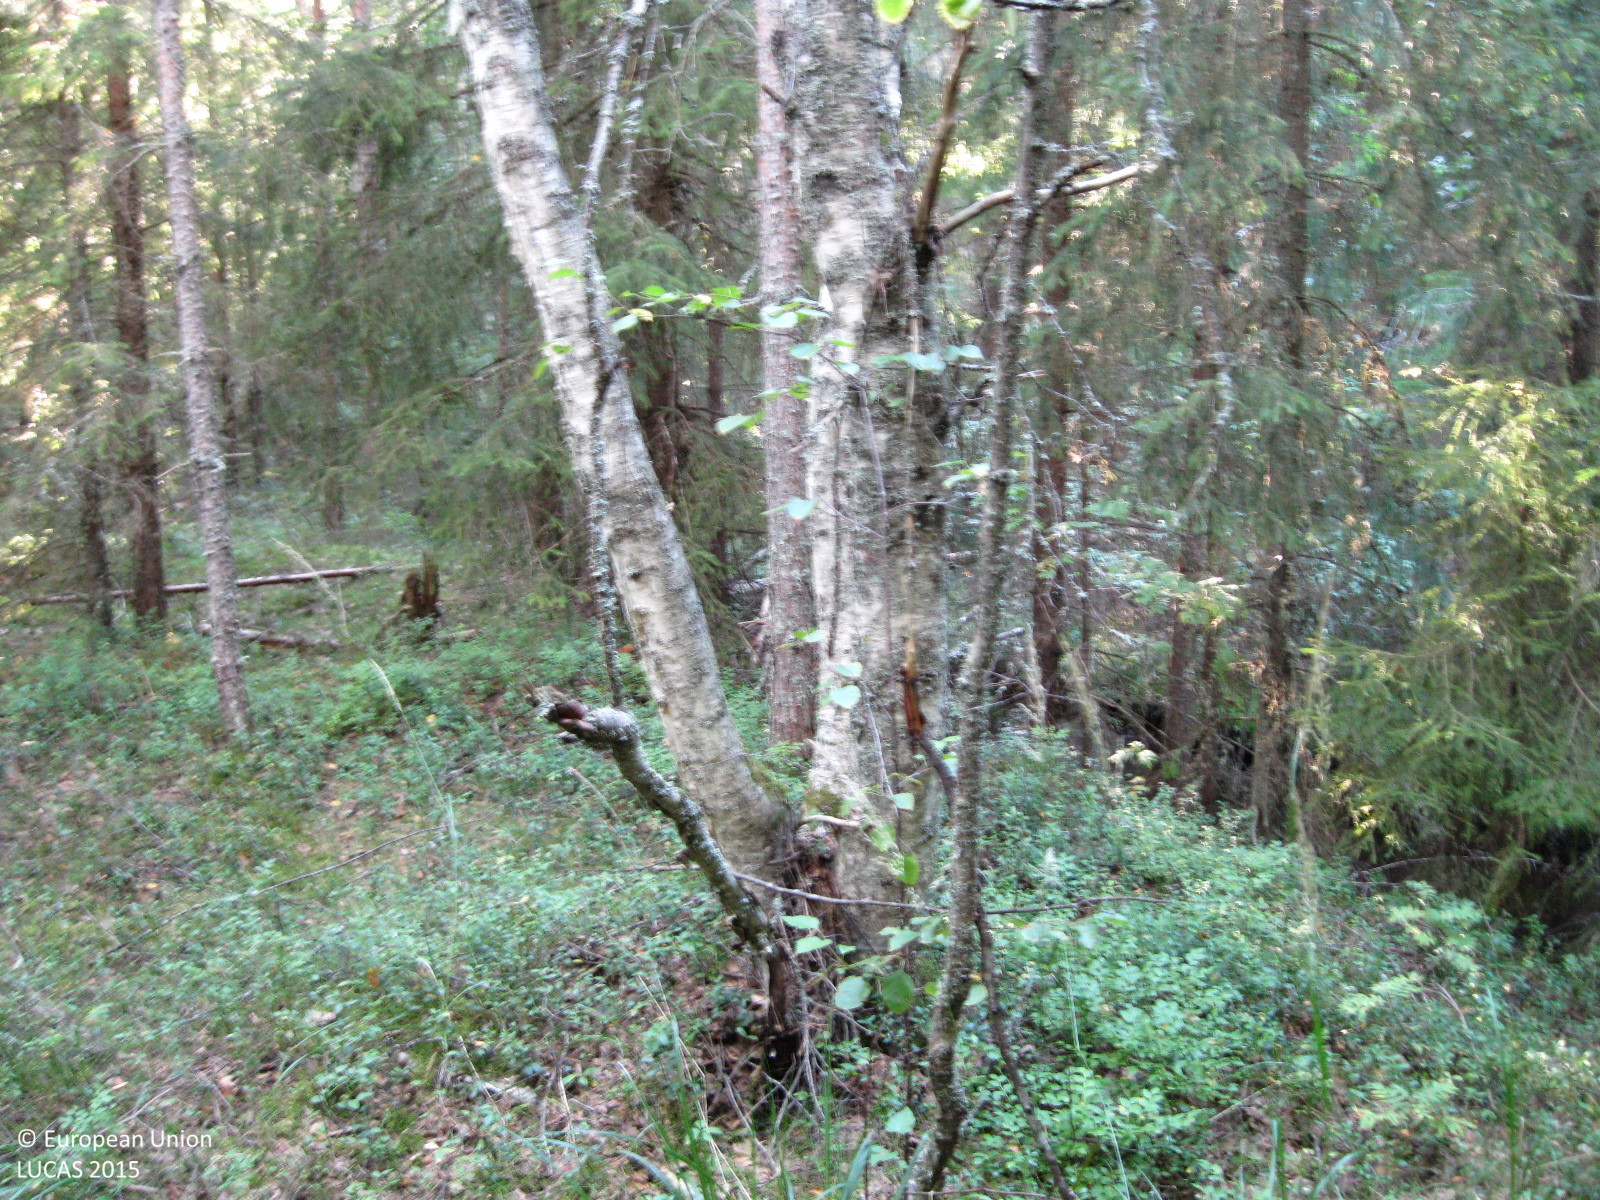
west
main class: Woodland
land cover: Pine dominated mixed woodland
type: boreal forest
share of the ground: > 75 %
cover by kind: coniferous forest trees 65 %, broadleaved forest trees 25 %, shrubs 5 %, herbaceous plants 5 %
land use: Forestry
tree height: > 5 m
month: August
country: FI
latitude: 61.2903
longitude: 25.2895
